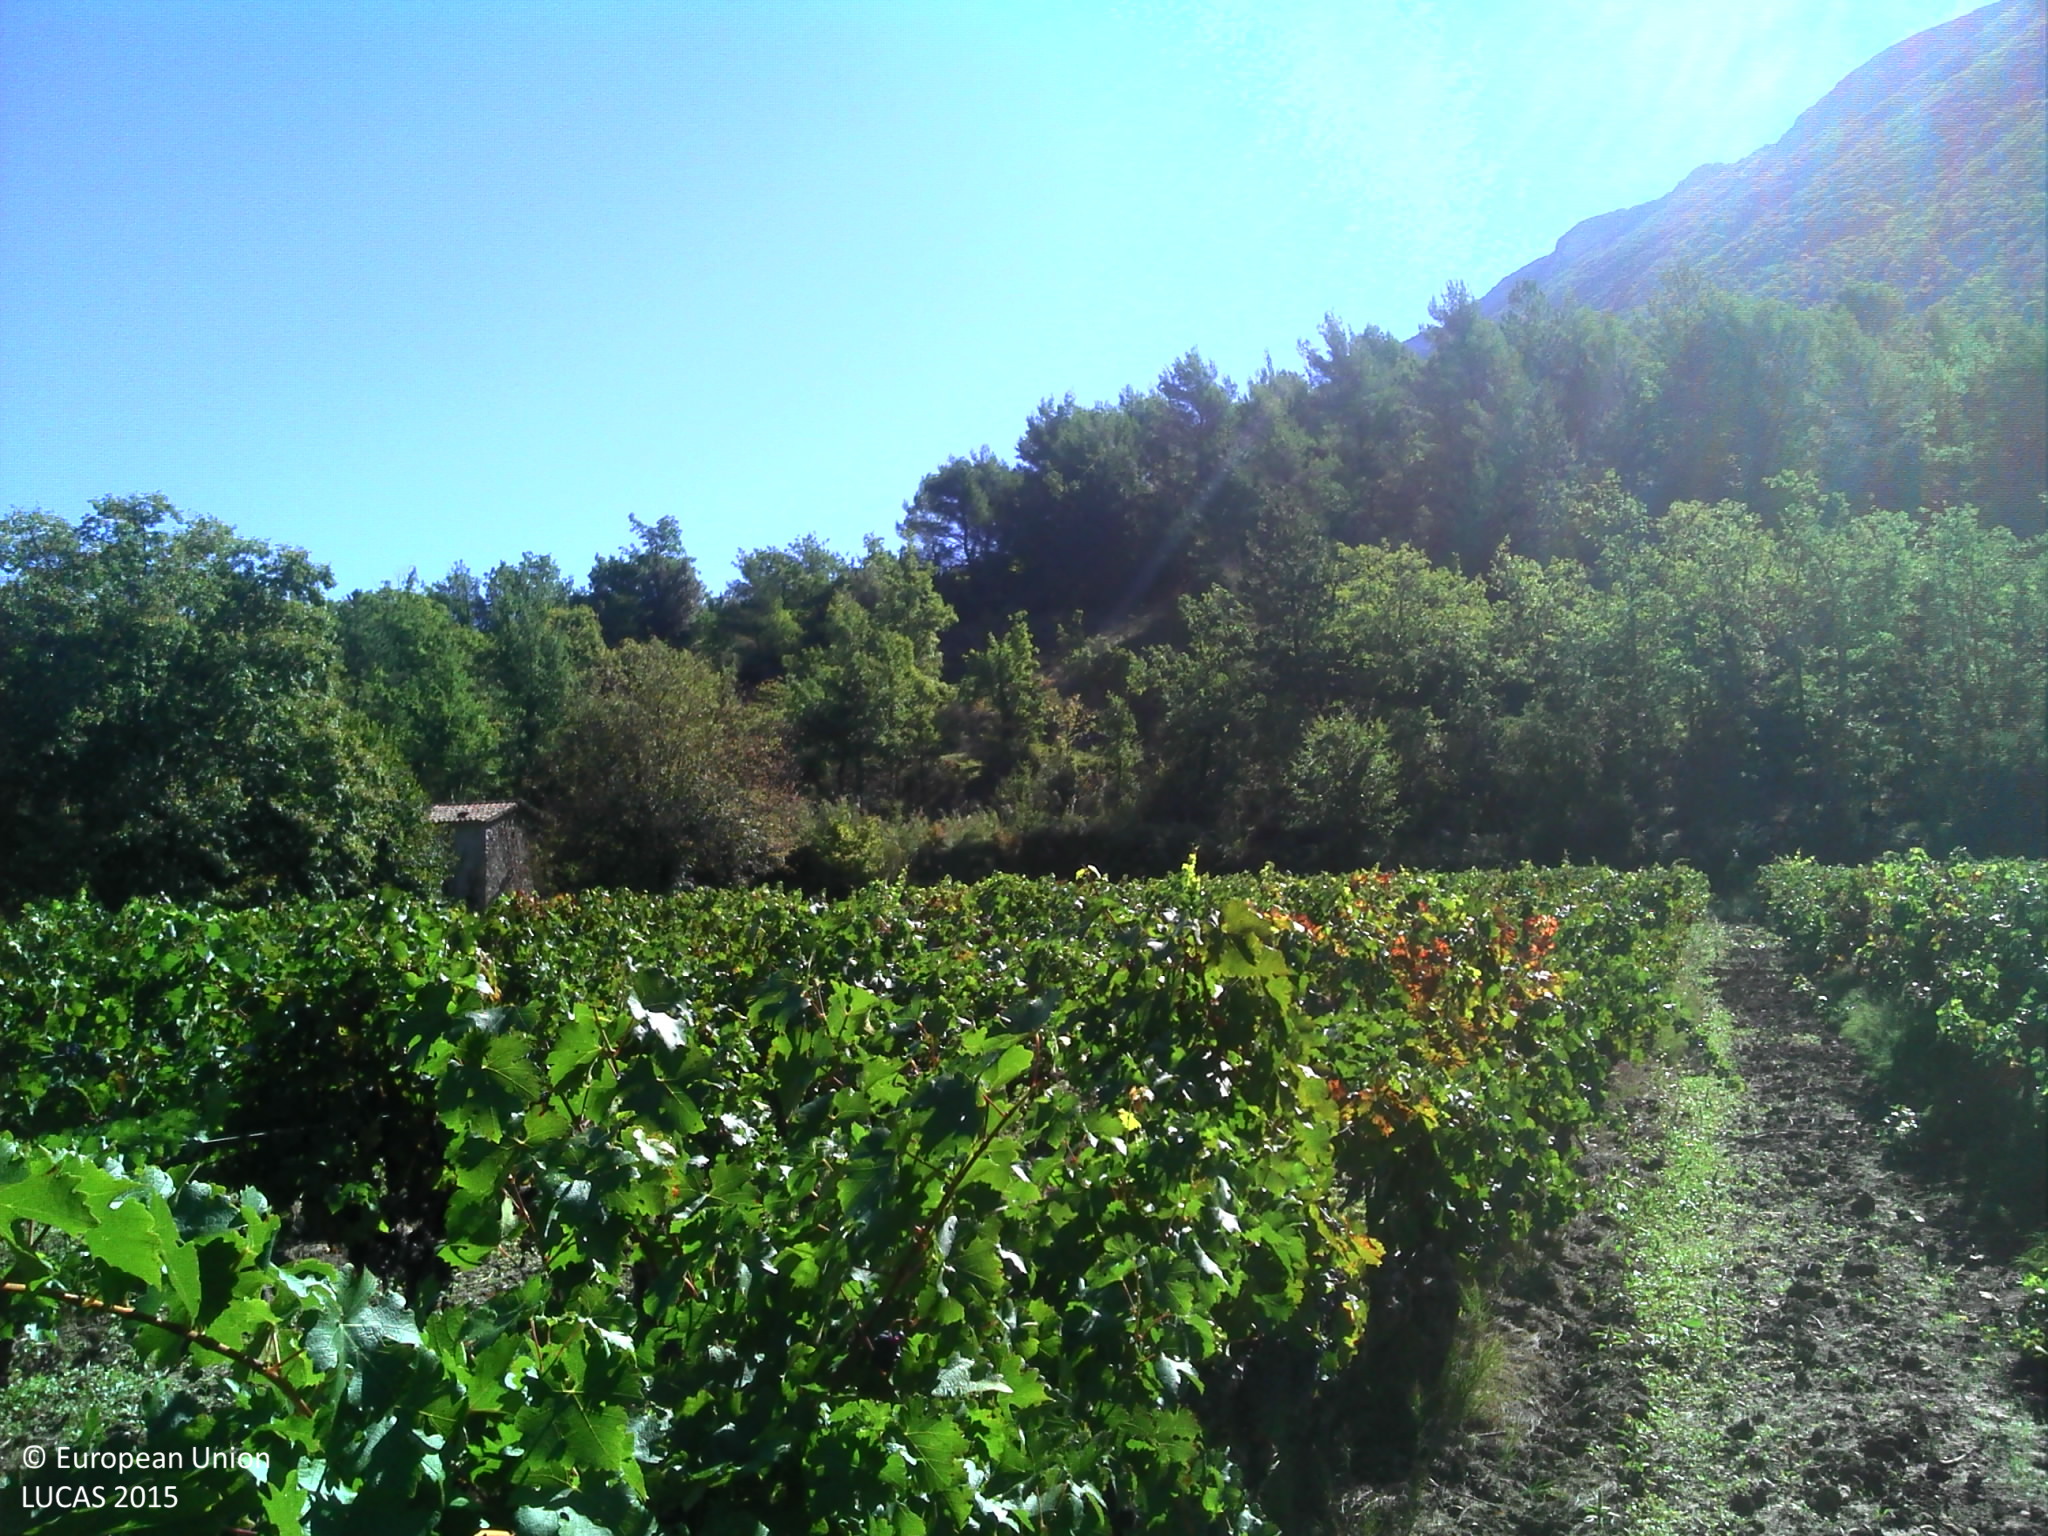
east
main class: Cropland
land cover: Vineyards
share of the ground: 50 - 75 %
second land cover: Spontaneously vegetated surfaces
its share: 10 - 25 %
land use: Agriculture (excluding fallow land and kitchen gardens)
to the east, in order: Vineyards; Spontaneously vegetated surfaces; Grassland without tree/shrub cover; Single bushes/trees; Grass margins; Abandoned hedges; Rivers and streams; Shrubland with sparse tree cover; Tracks; Broadleaved woodland; Tracks; Vineyards; Broadleaved woodland; Tracks; Shrubland with sparse tree cover; Vineyards
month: September
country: FR
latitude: 44.2401
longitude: 5.2120
